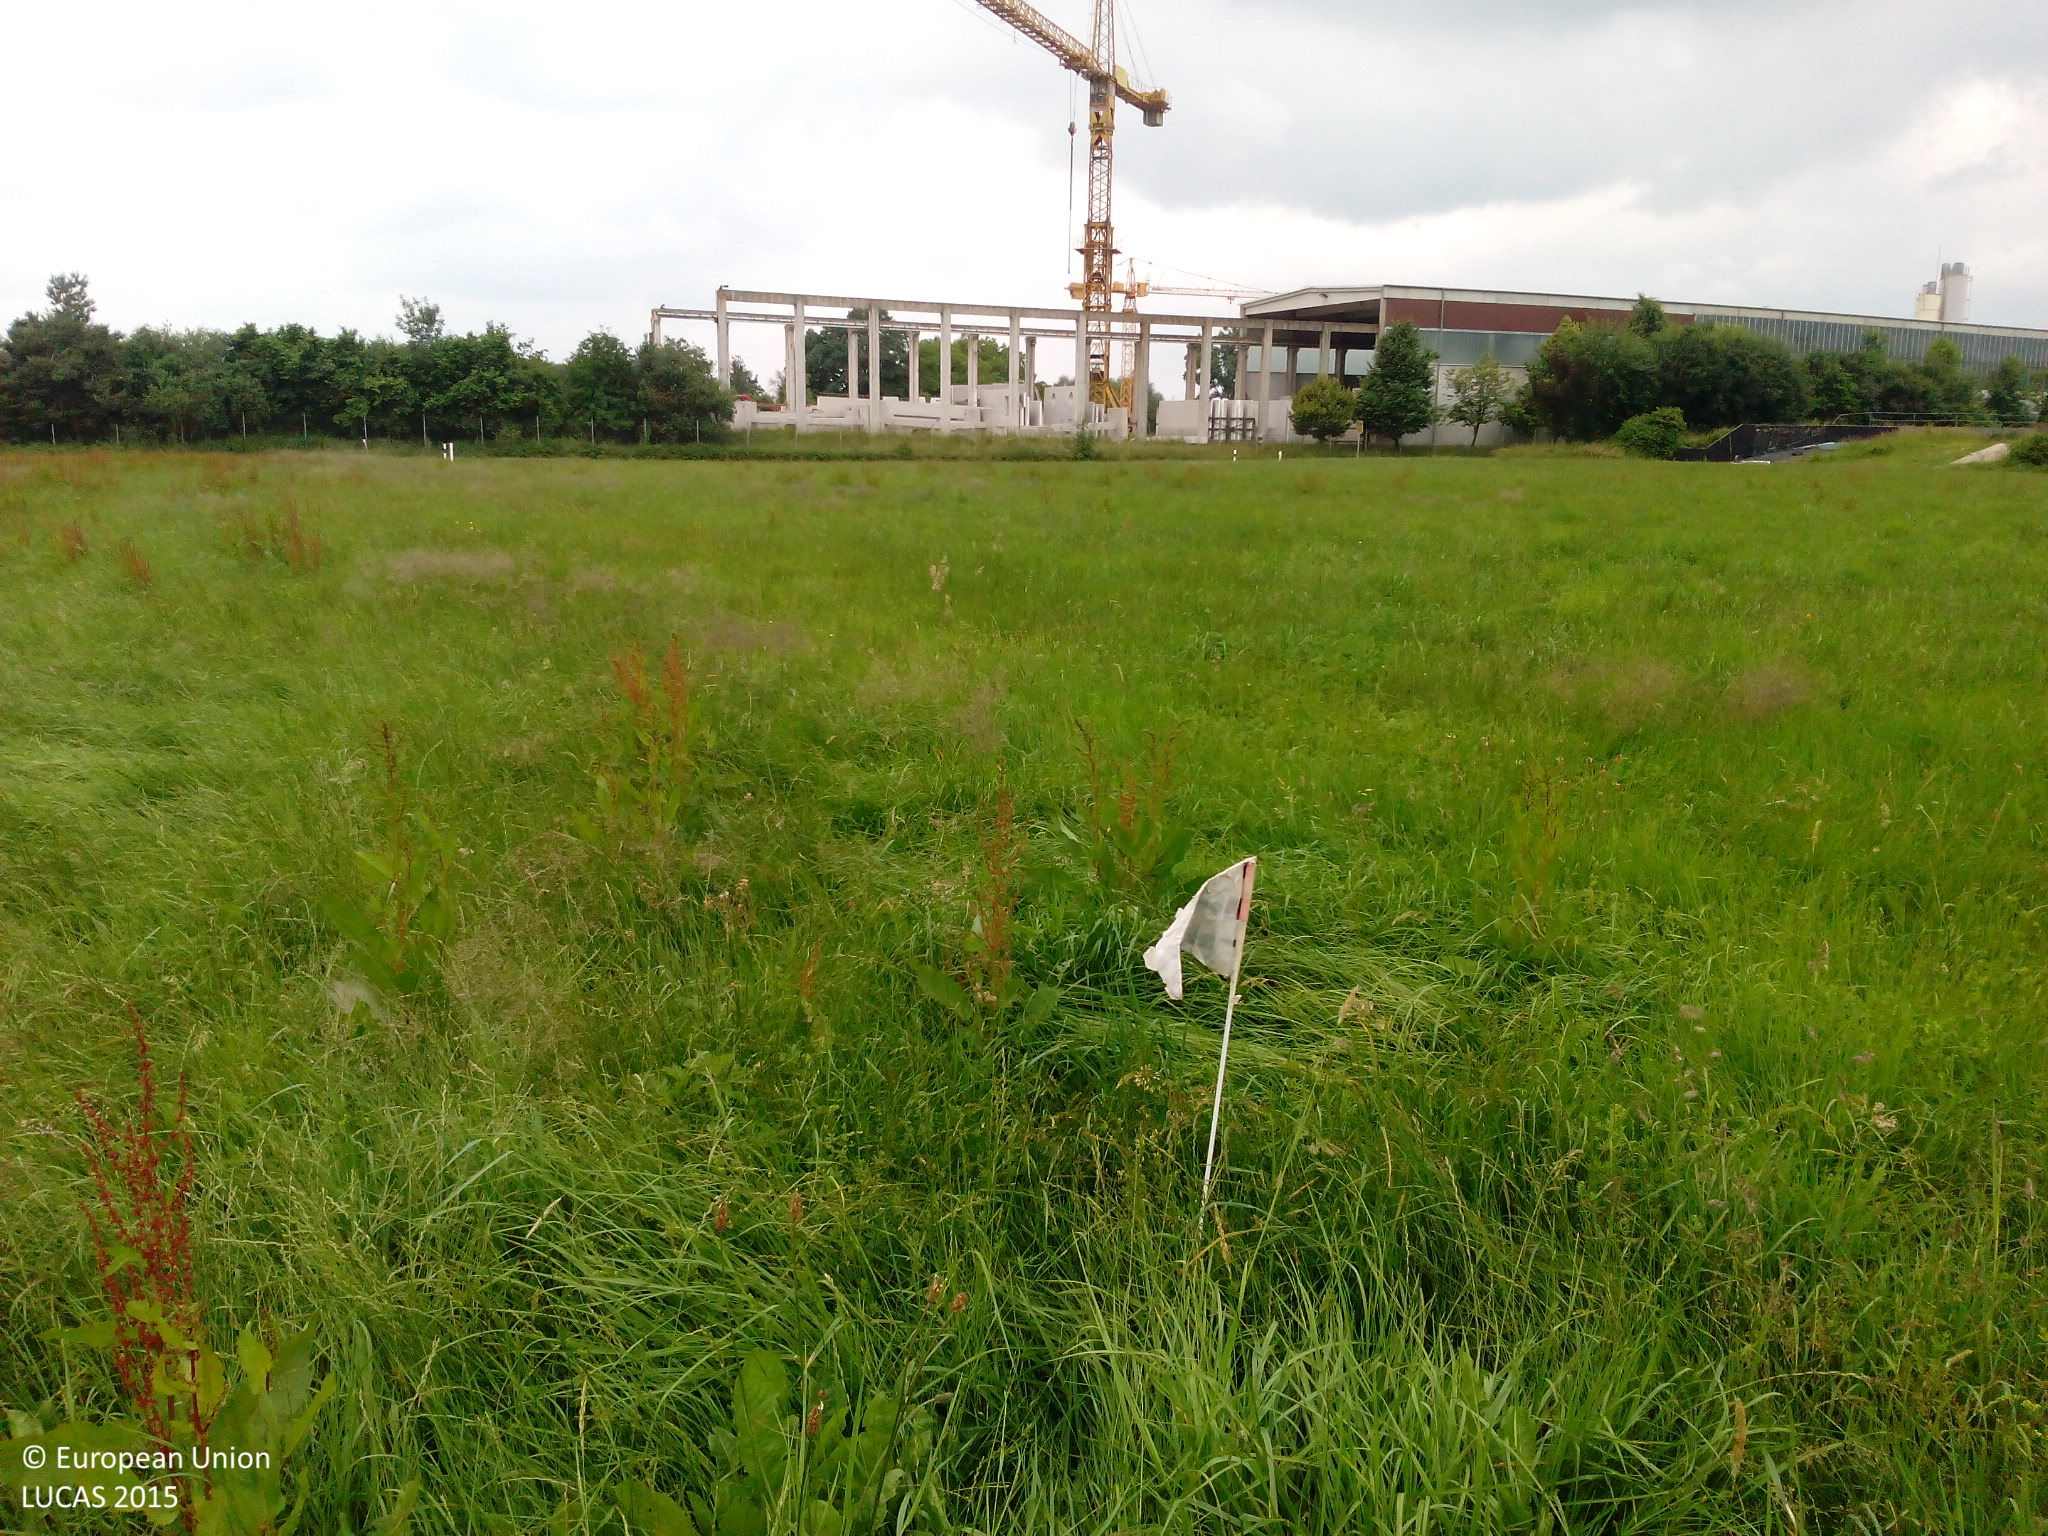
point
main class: Grassland
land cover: Grassland without tree/shrub cover
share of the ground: > 75 %
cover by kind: herbaceous plants 90 %, unconsolidated bare surface 10 %
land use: Agriculture (excluding fallow land and kitchen gardens)
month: June
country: DE
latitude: 49.0656
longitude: 10.8893
